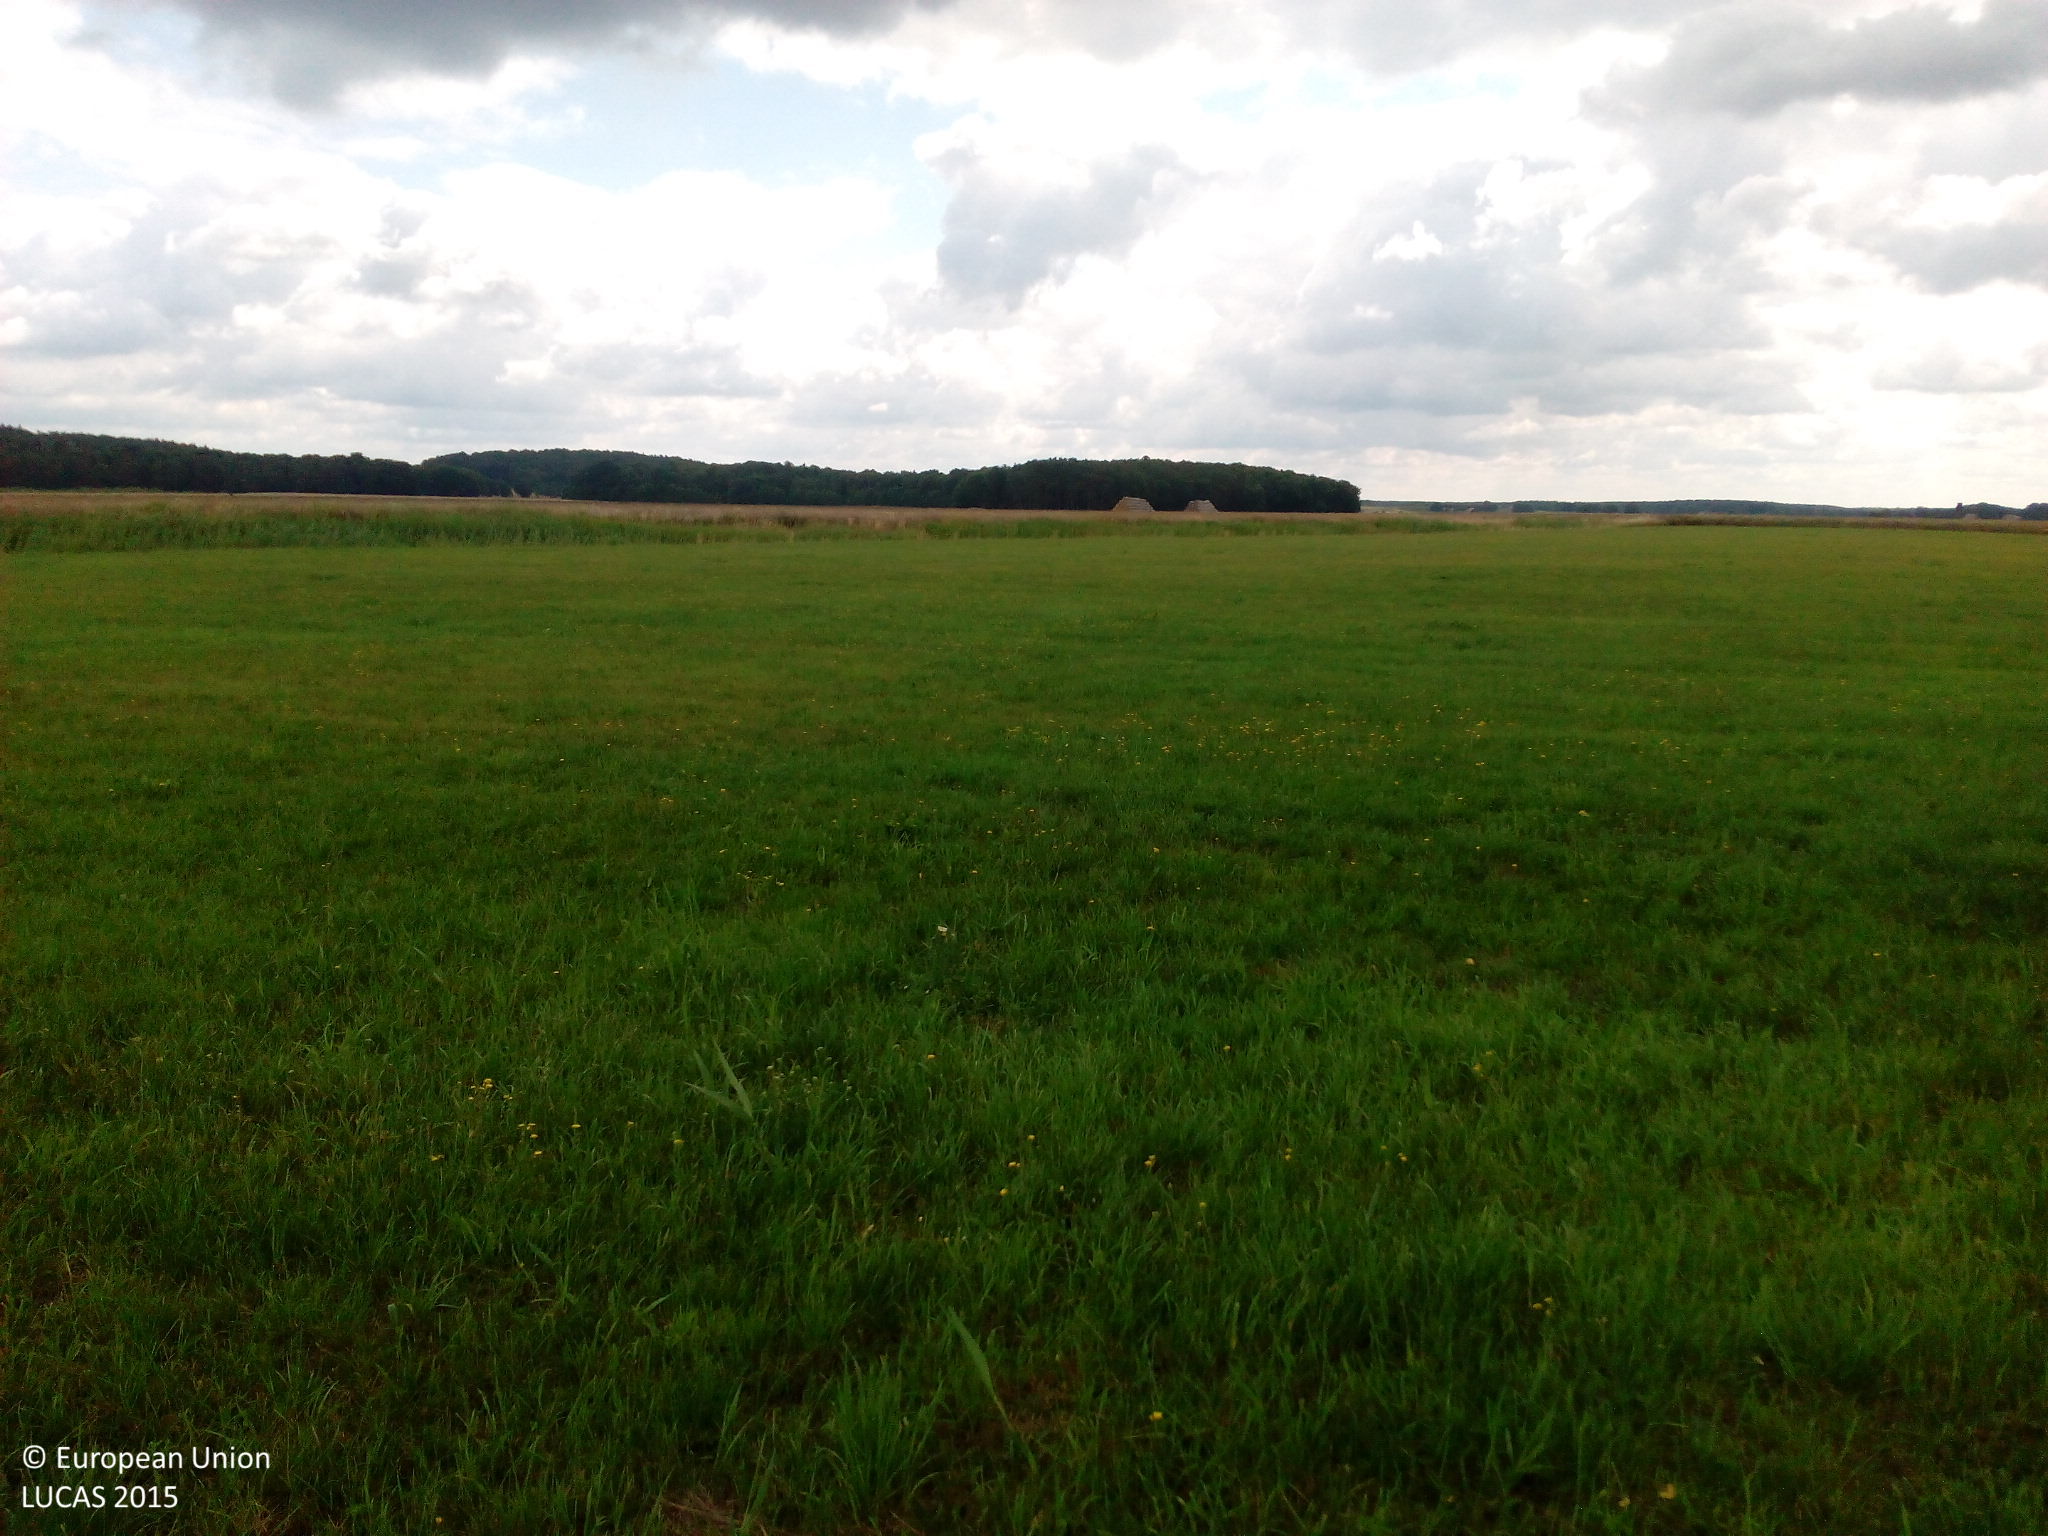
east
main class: Grassland
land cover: Grassland without tree/shrub cover
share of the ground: > 75 %
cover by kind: herbaceous plants 100 %
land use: Agriculture (excluding fallow land and kitchen gardens)
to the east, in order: Grassland without tree/shrub cover; Tracks; Grassland without tree/shrub cover; Ditches and canals; Rape and turnip rape
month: July
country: DE
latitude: 52.7114
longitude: 12.4715
